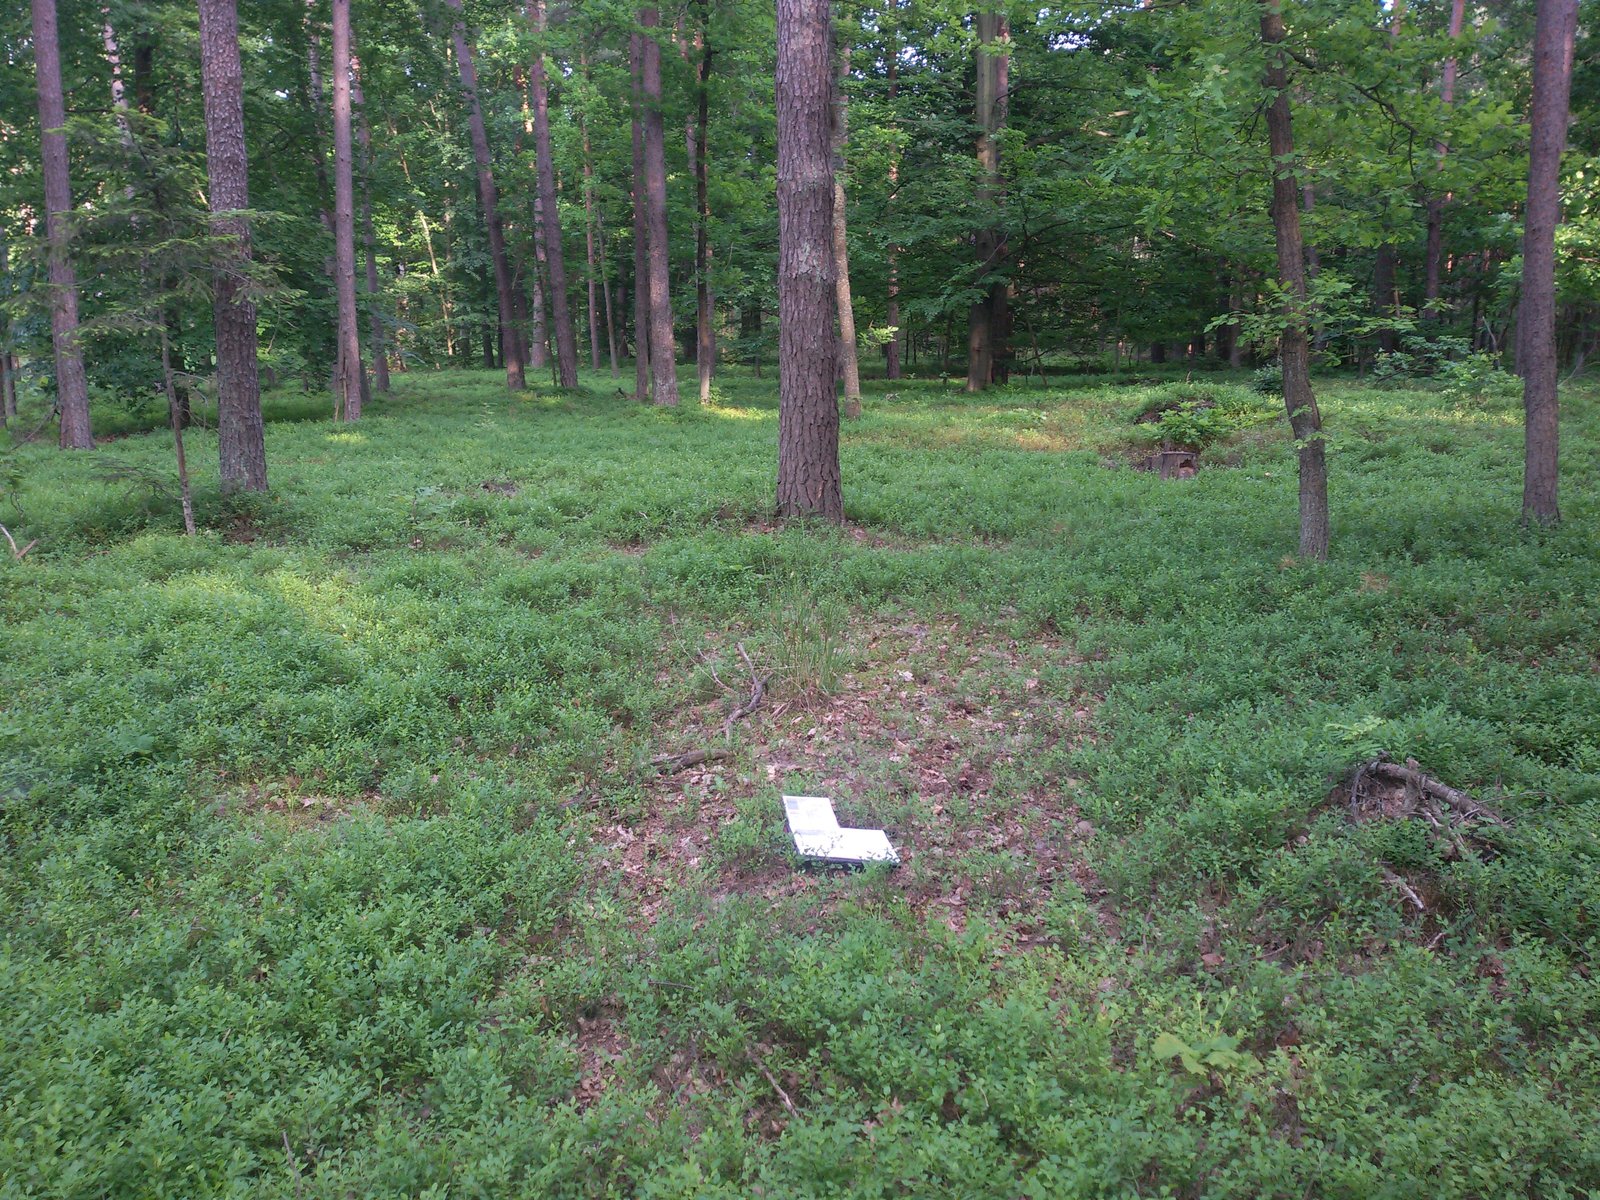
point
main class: Woodland
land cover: Pine dominated coniferous woodland
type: hemiboreal forest and nemoral coniferous forest and mixed broadleaved-coniferous forest
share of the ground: 25 - 50 %
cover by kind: coniferous forest trees 45 %, shrubs 30 %, herbaceous plants 20 %, lichens and mosses 5 %
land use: Forestry
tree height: > 5 m
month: June
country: PL
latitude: 50.1859
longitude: 21.6347
